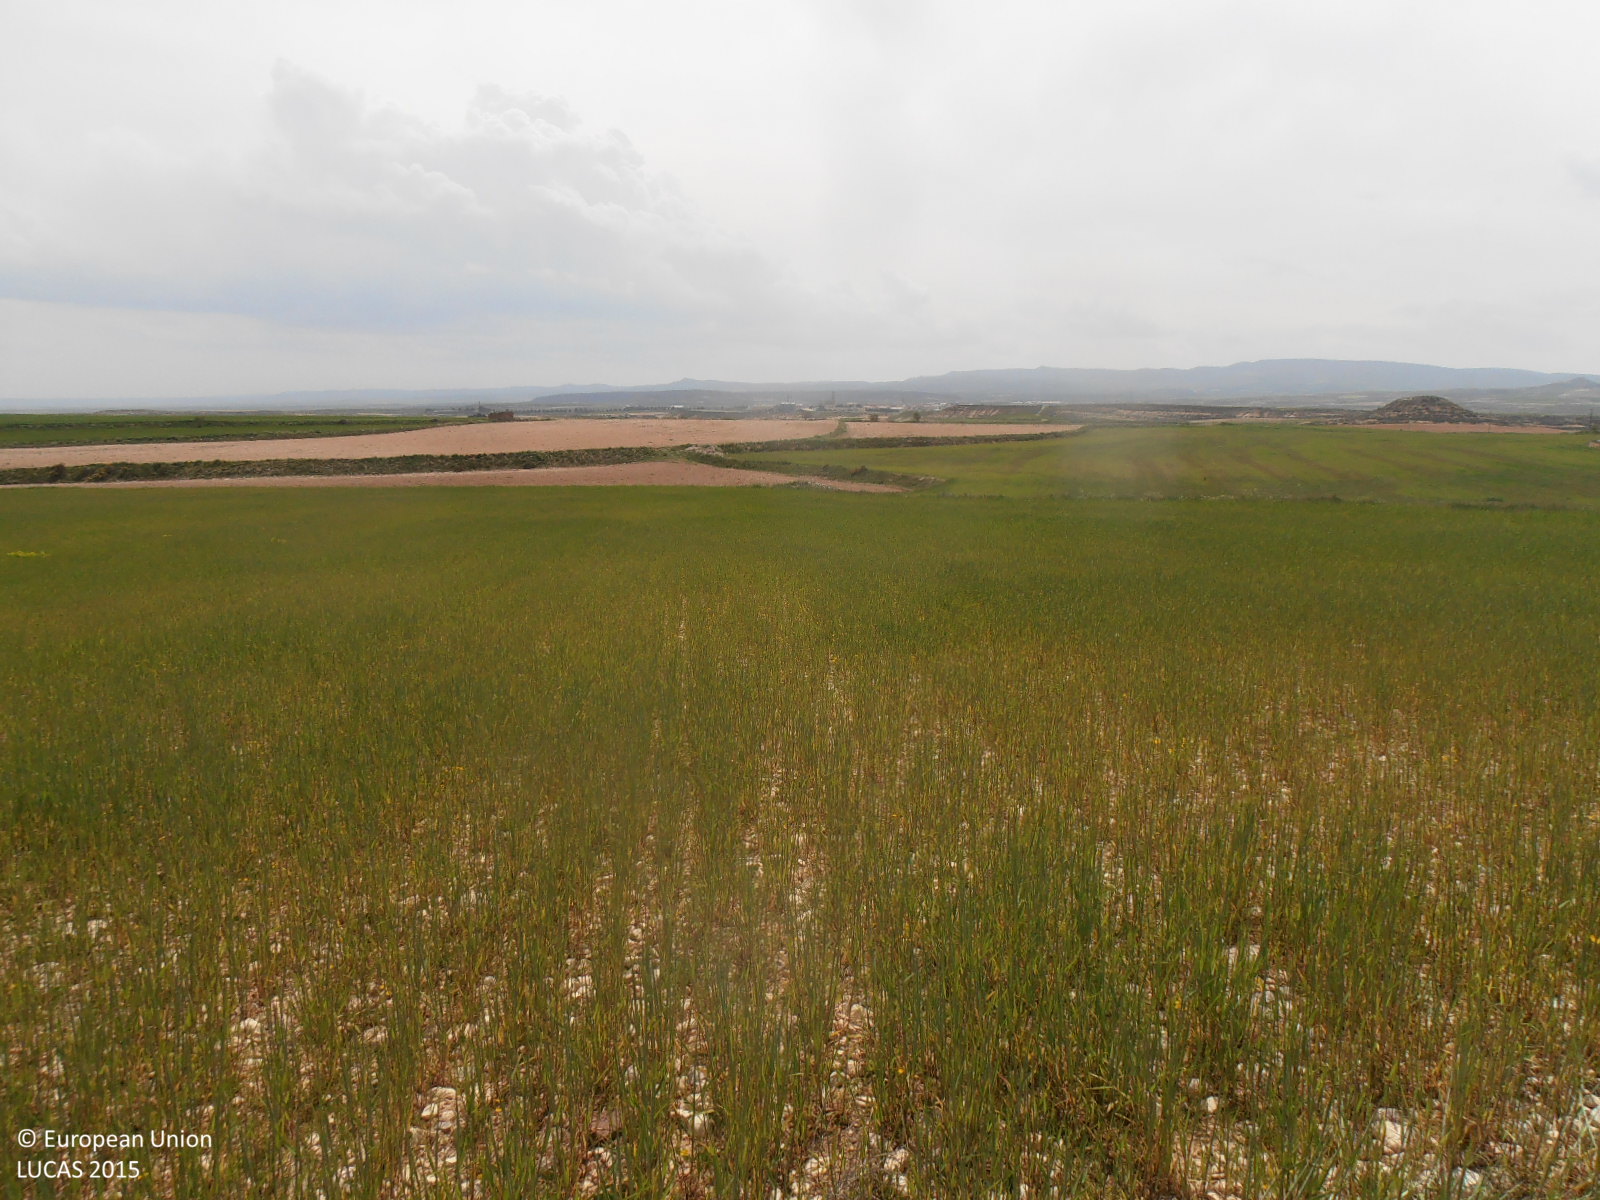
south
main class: Cropland
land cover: Barley
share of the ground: > 75 %
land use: Agriculture (excluding fallow land and kitchen gardens)
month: April
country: ES
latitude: 41.2278
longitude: -0.7176
